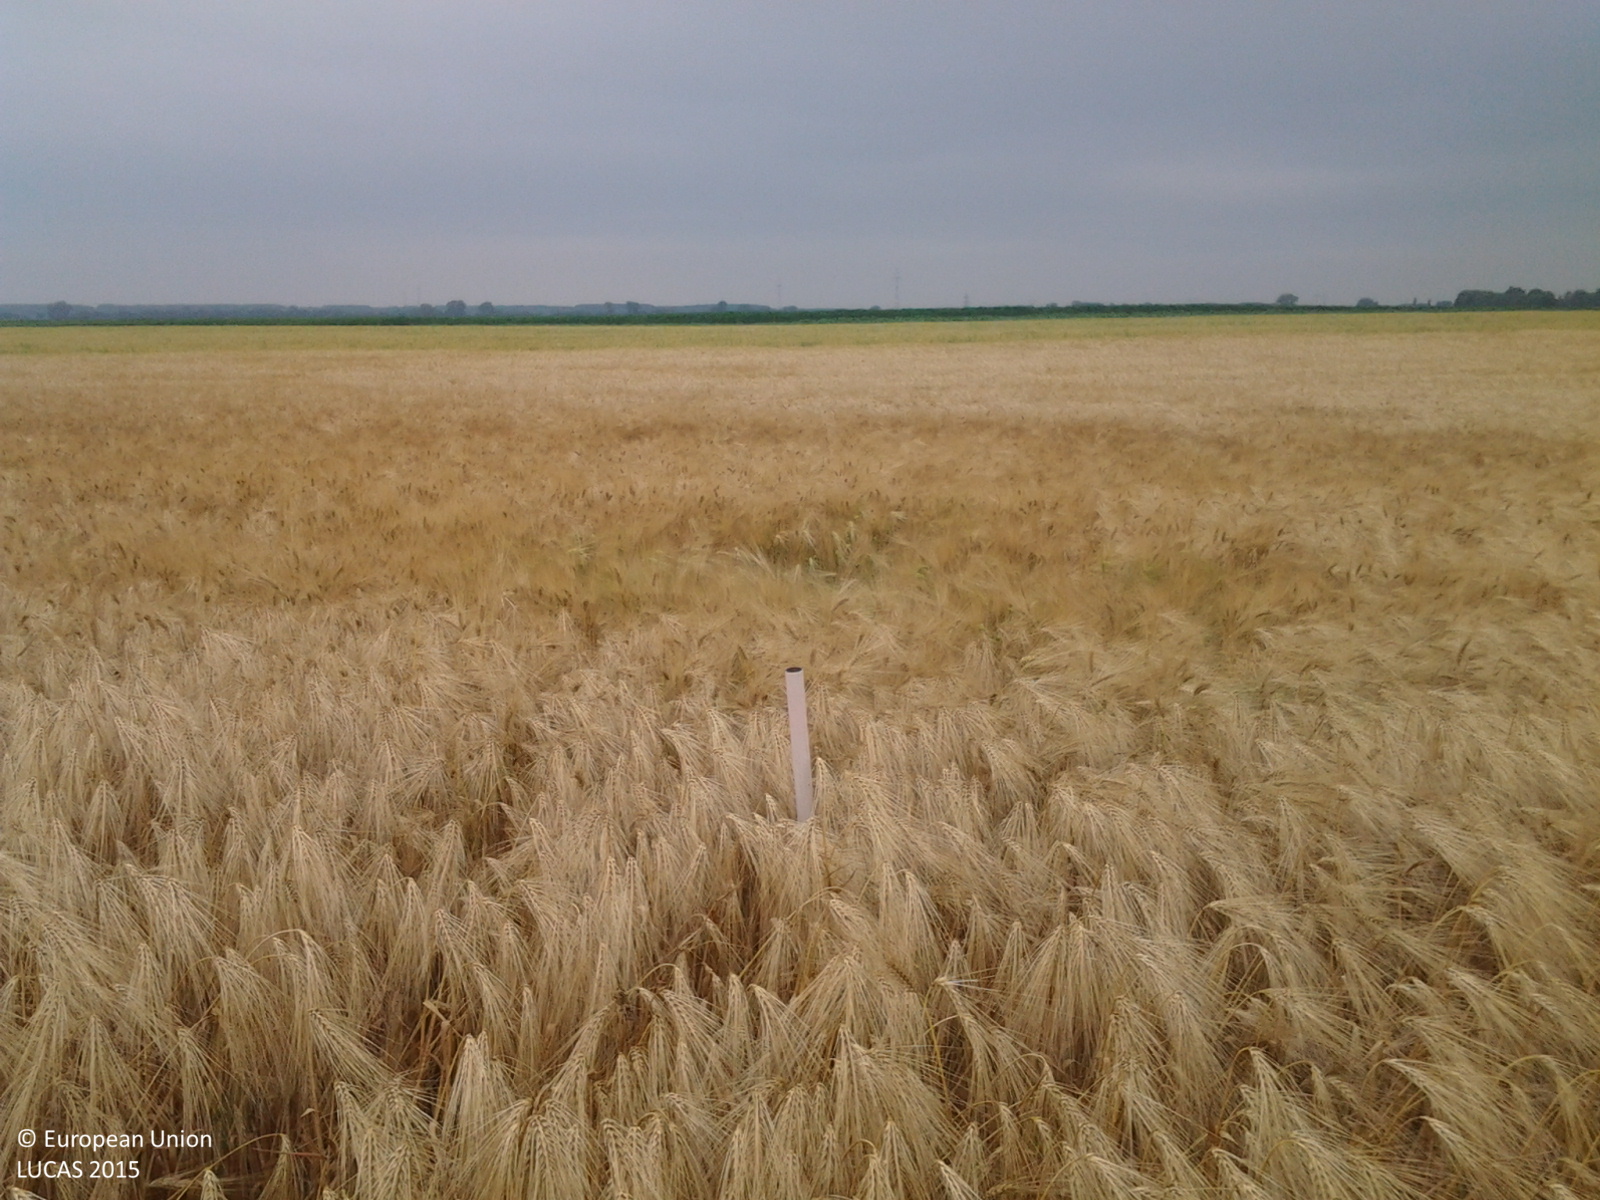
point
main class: Cropland
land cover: Barley
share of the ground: > 75 %
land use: Agriculture (excluding fallow land and kitchen gardens)
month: June
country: HU
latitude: 46.4616
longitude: 18.9849
